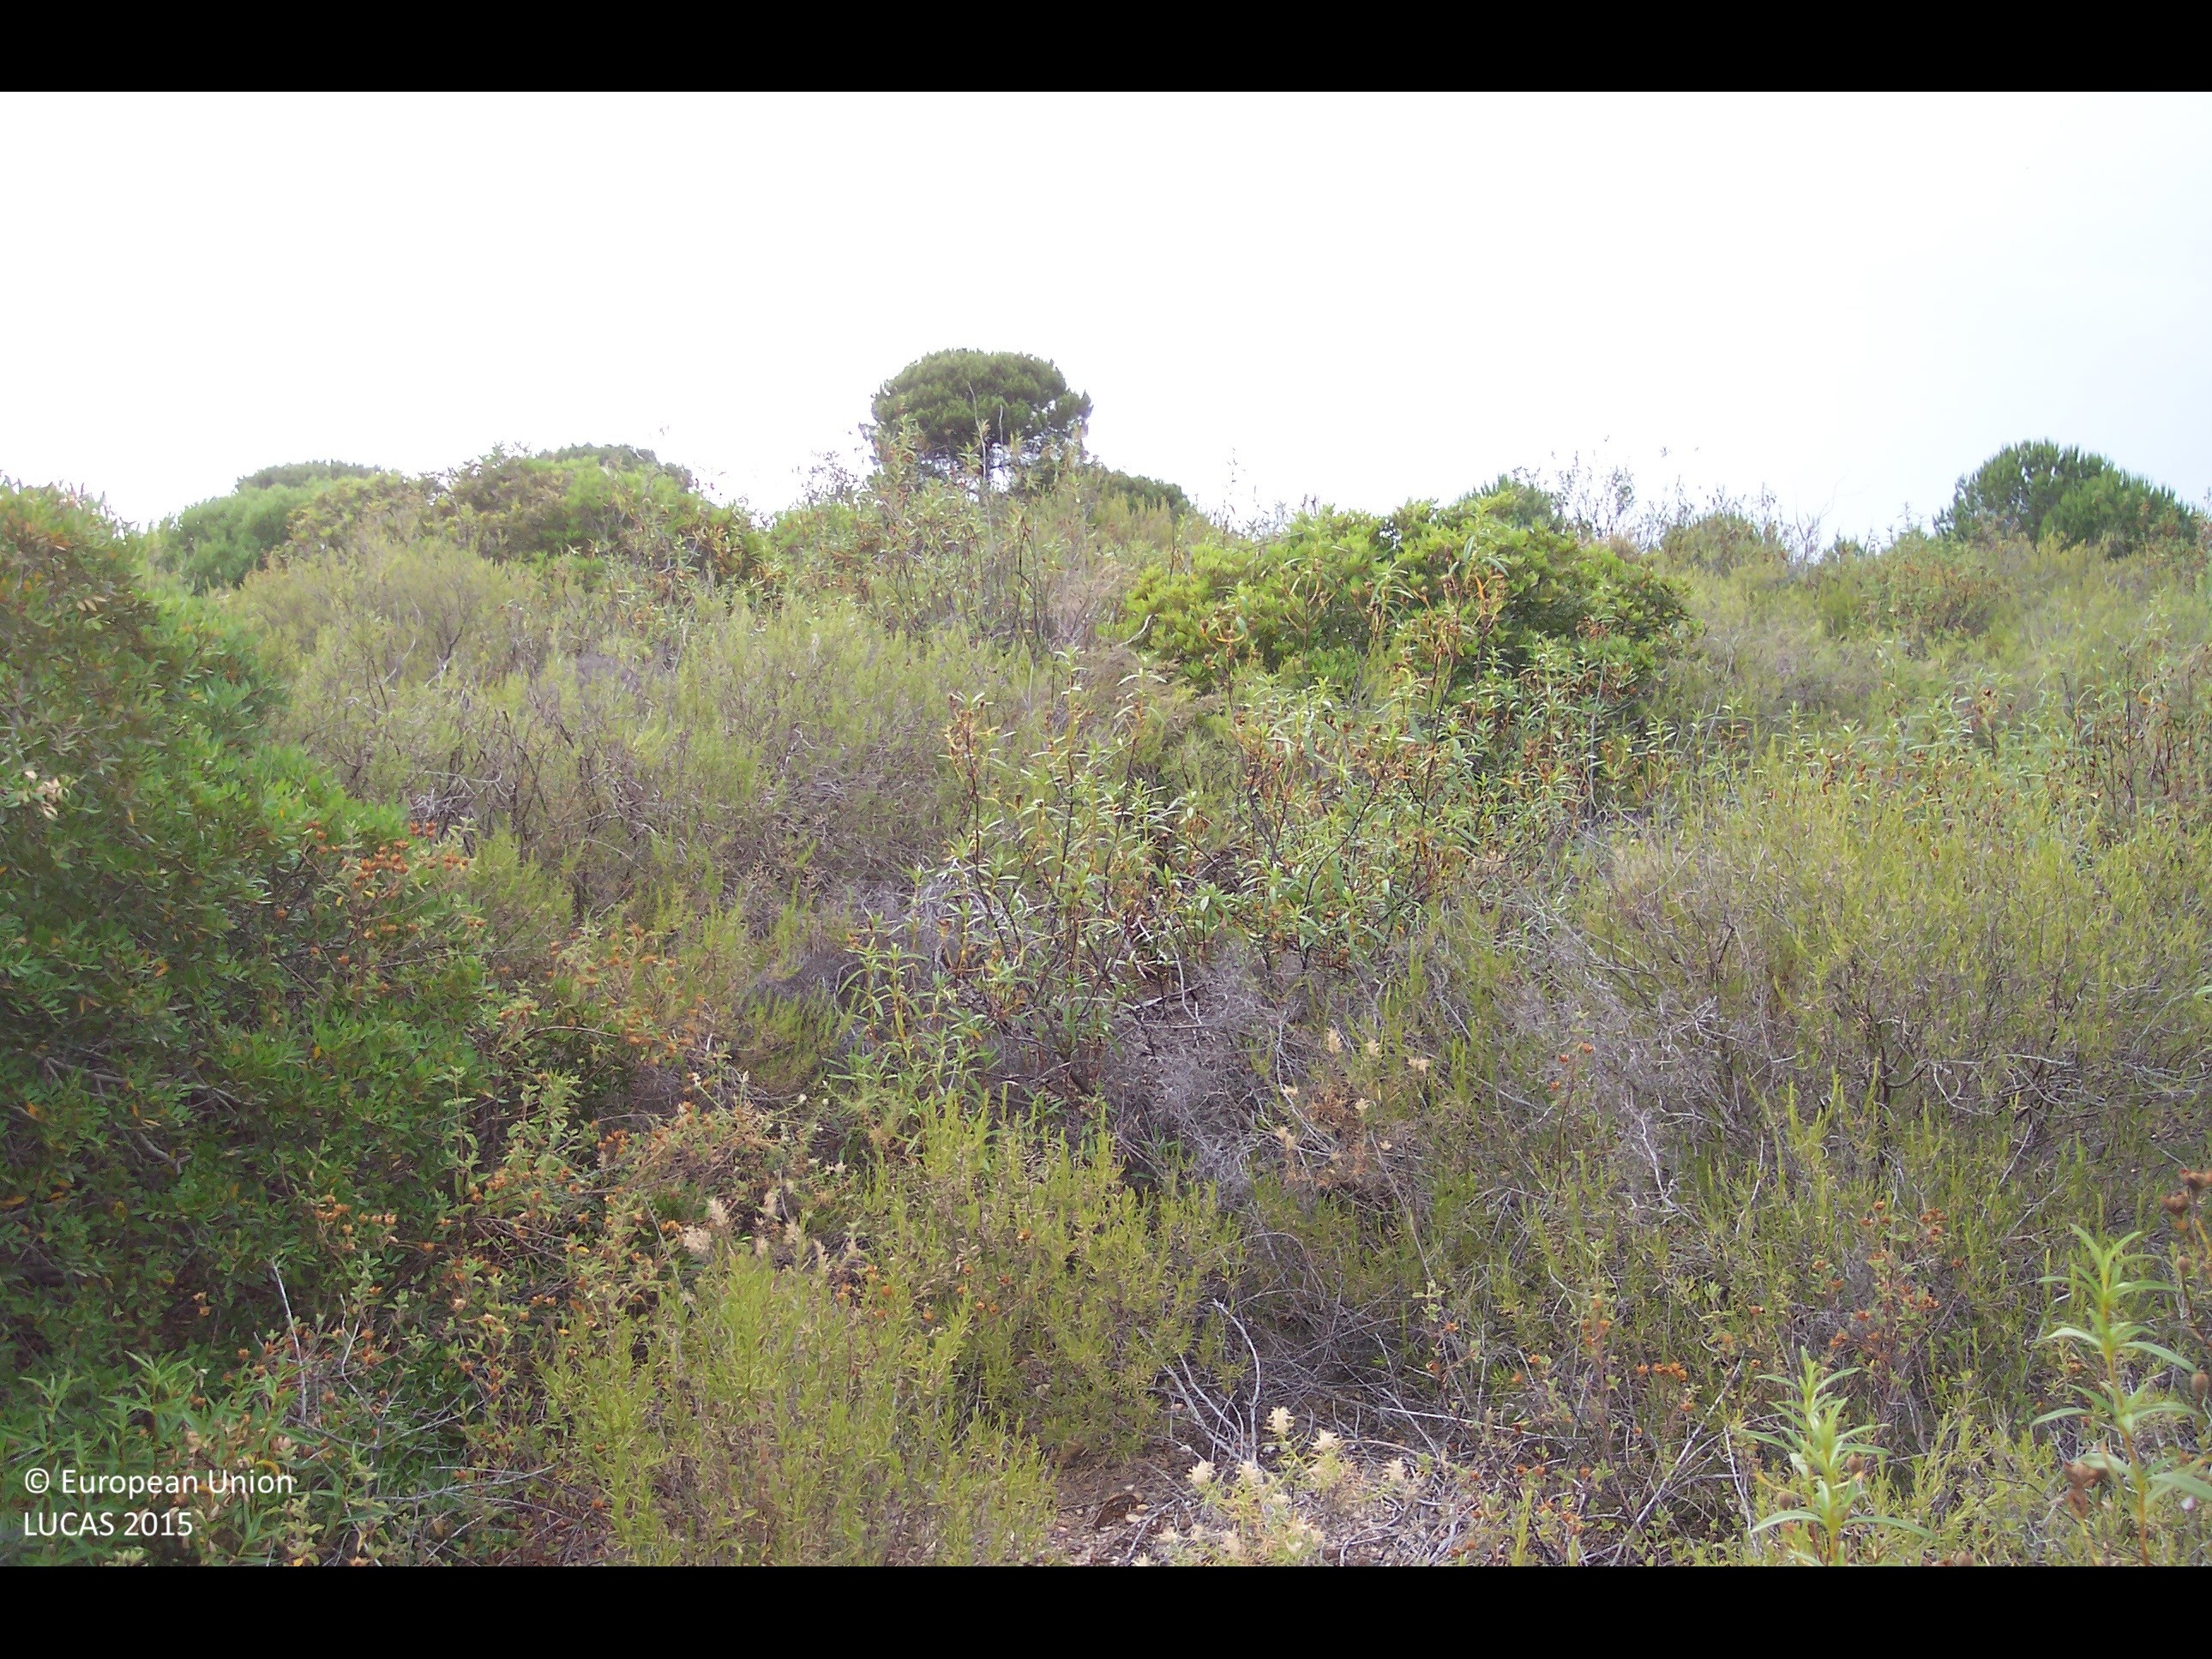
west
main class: Shrubland
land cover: Shrubland without tree cover
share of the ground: > 75 %
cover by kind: shrubs 75 %, herbaceous plants 25 %
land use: Semi-natural and natural areas not in use
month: June
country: ES
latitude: 37.2671
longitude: -6.1151
